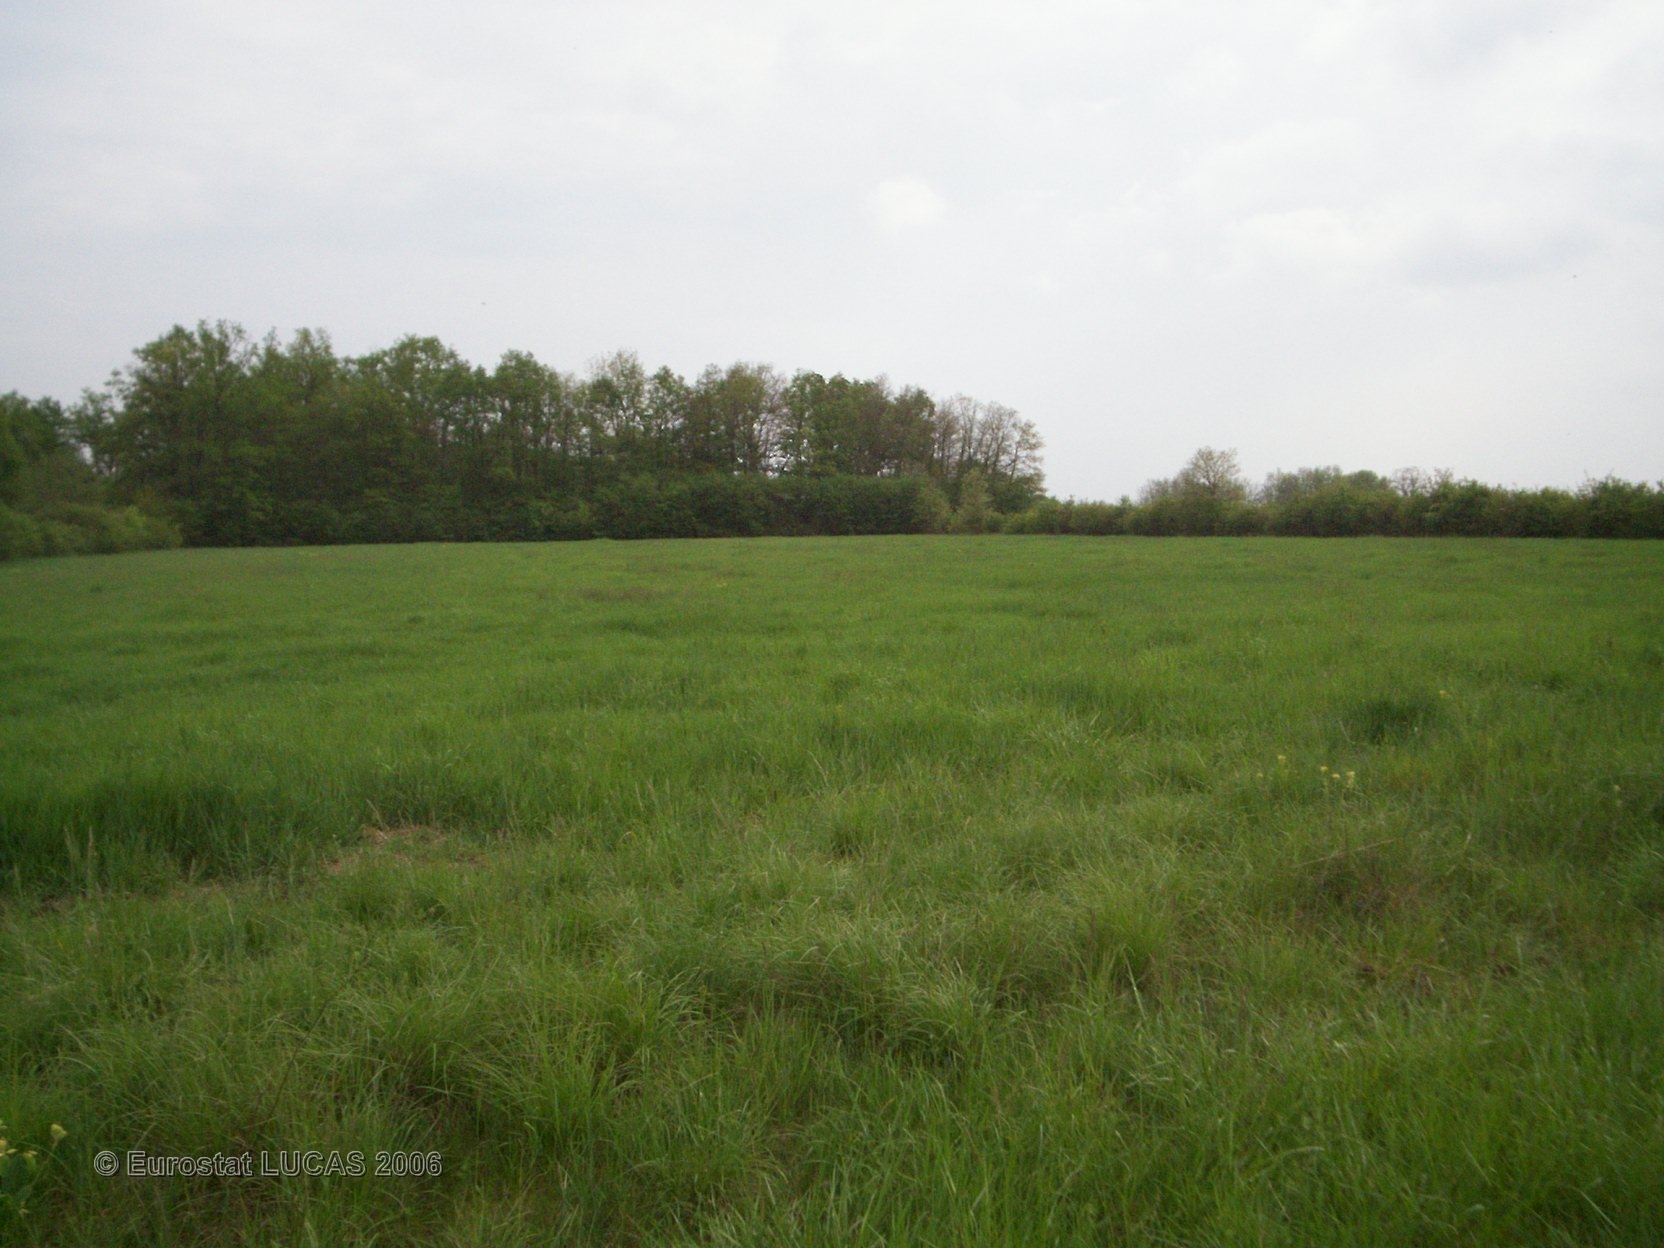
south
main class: Grassland
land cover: Grassland without tree/shrub cover
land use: Agriculture (excluding fallow land and kitchen gardens)
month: May
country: FR
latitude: 47.4164
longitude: 0.5288
